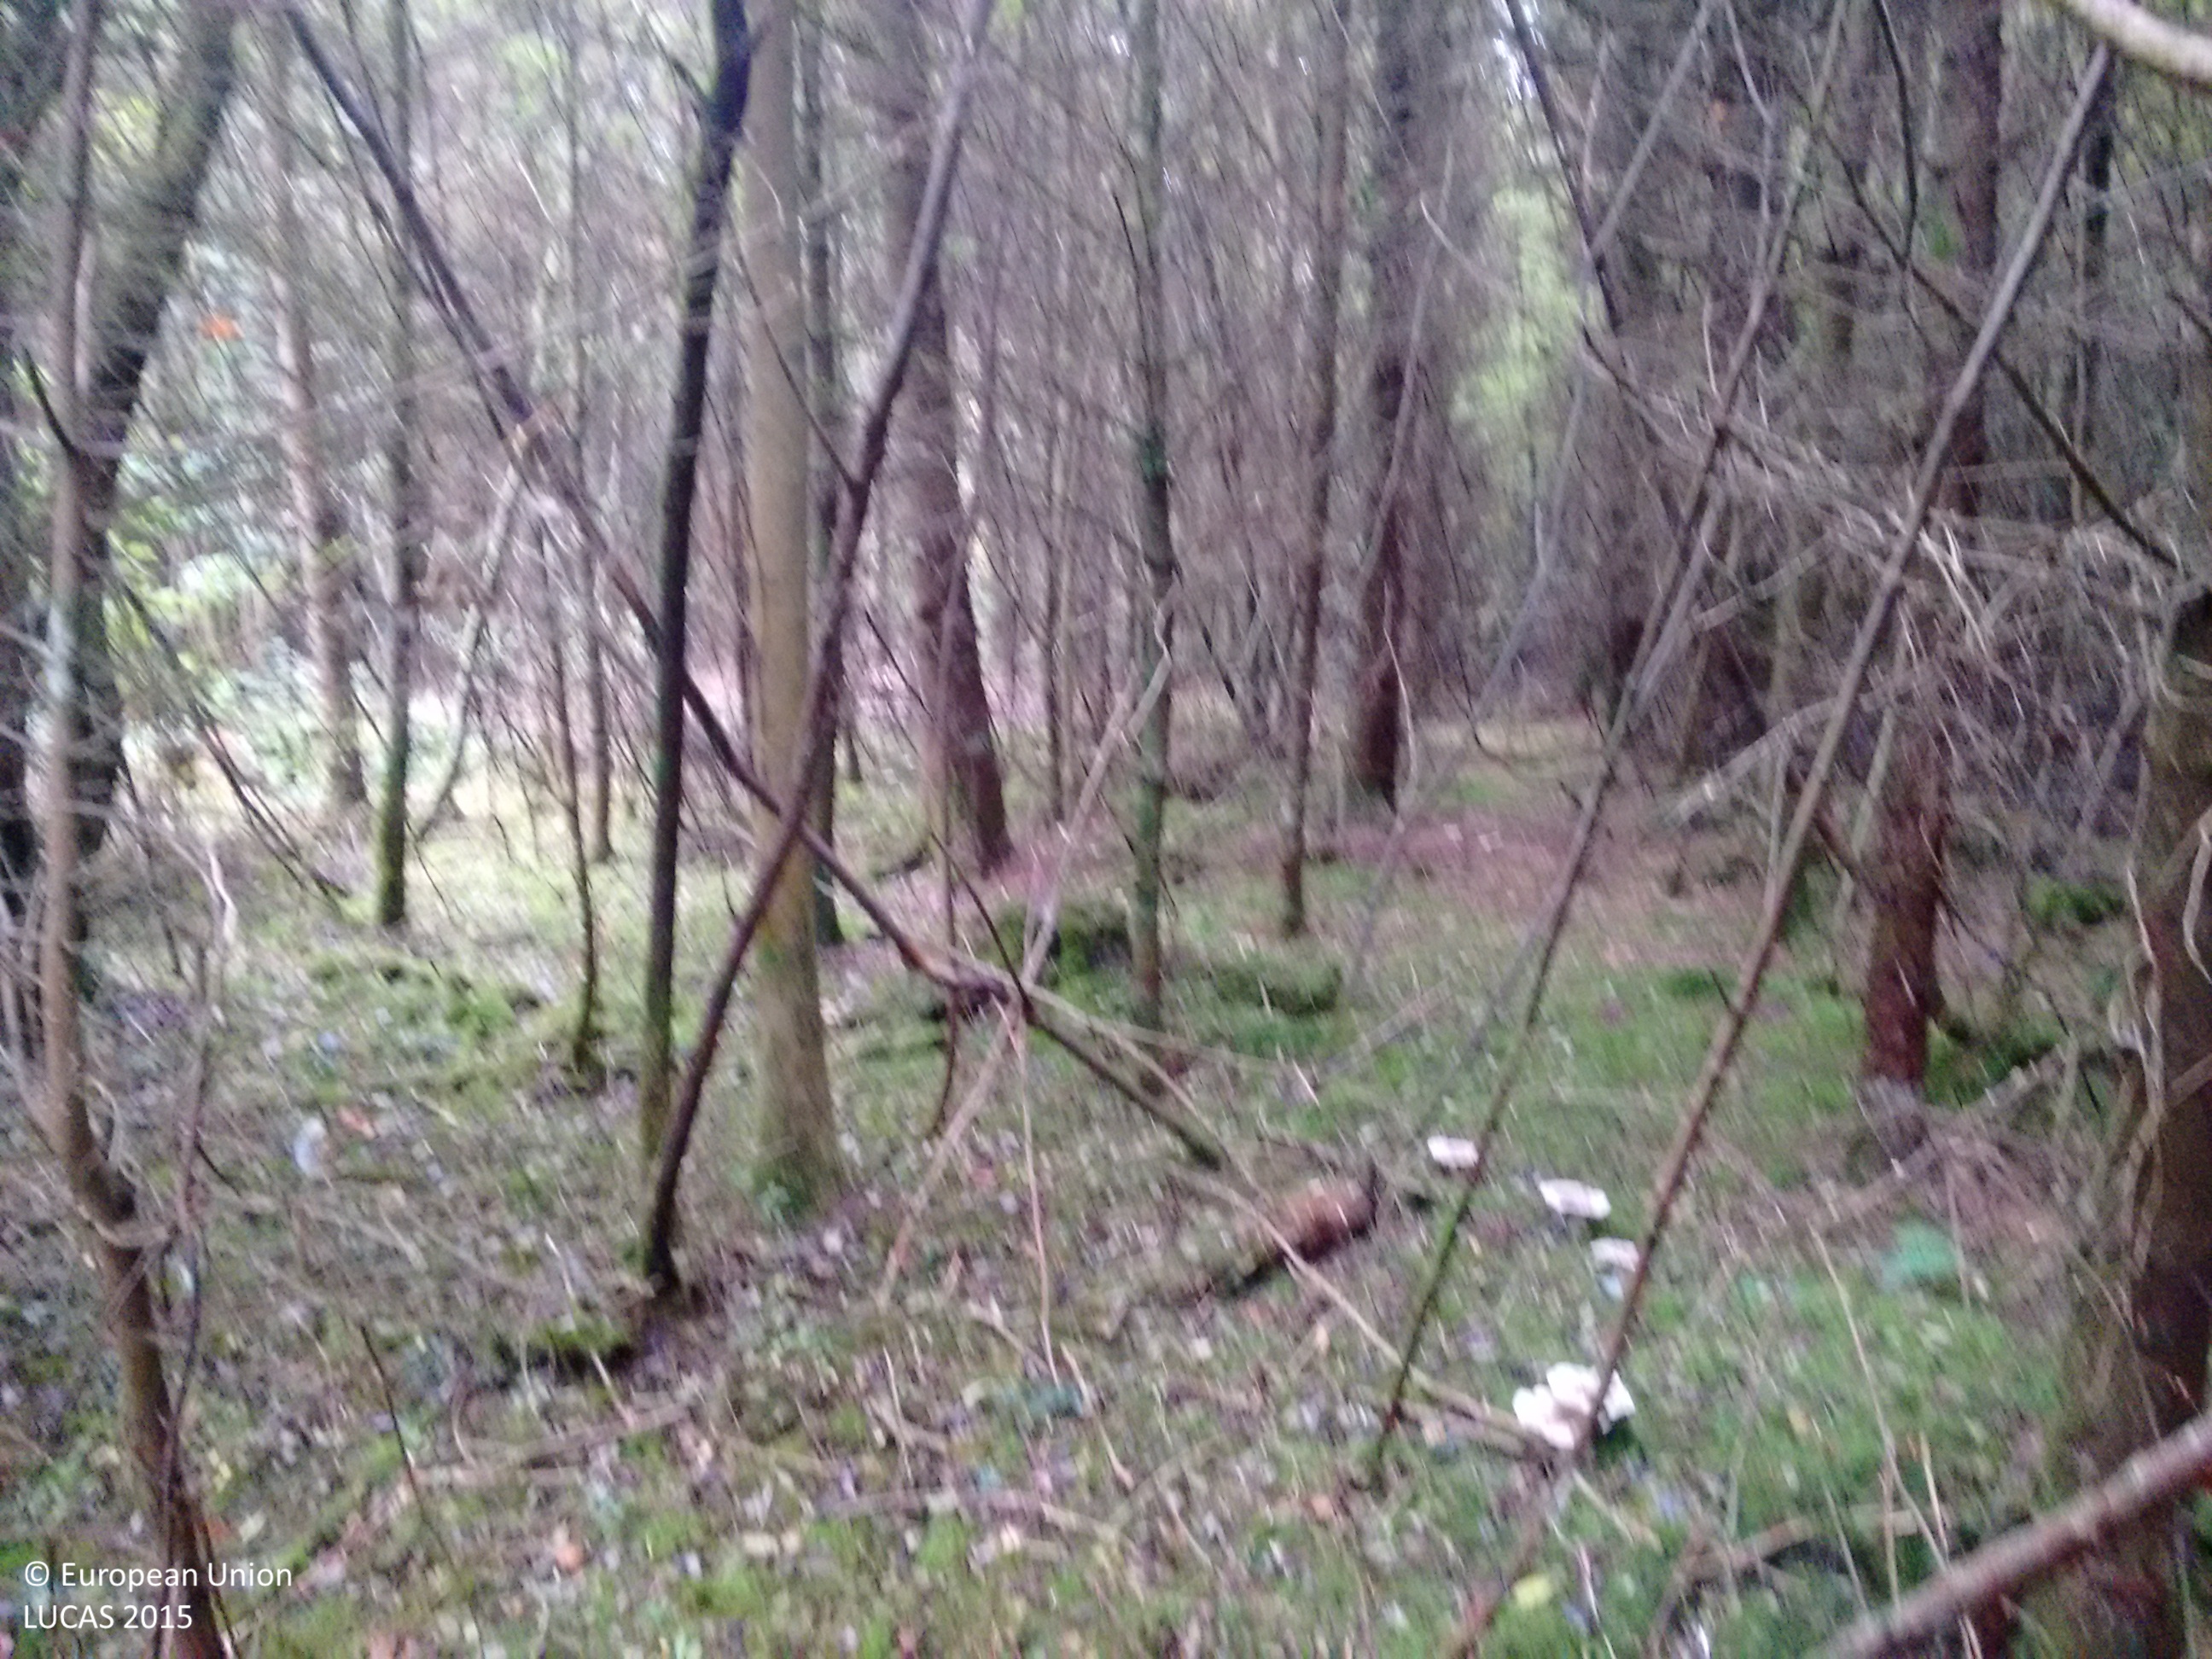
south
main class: Woodland
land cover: Spruce dominated mixed woodland
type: exotic forest
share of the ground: > 75 %
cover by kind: coniferous forest trees 75 %, broadleaved forest trees 25 %
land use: Forestry
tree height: > 5 m
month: October
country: IE
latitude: 52.8427
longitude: -7.4228
